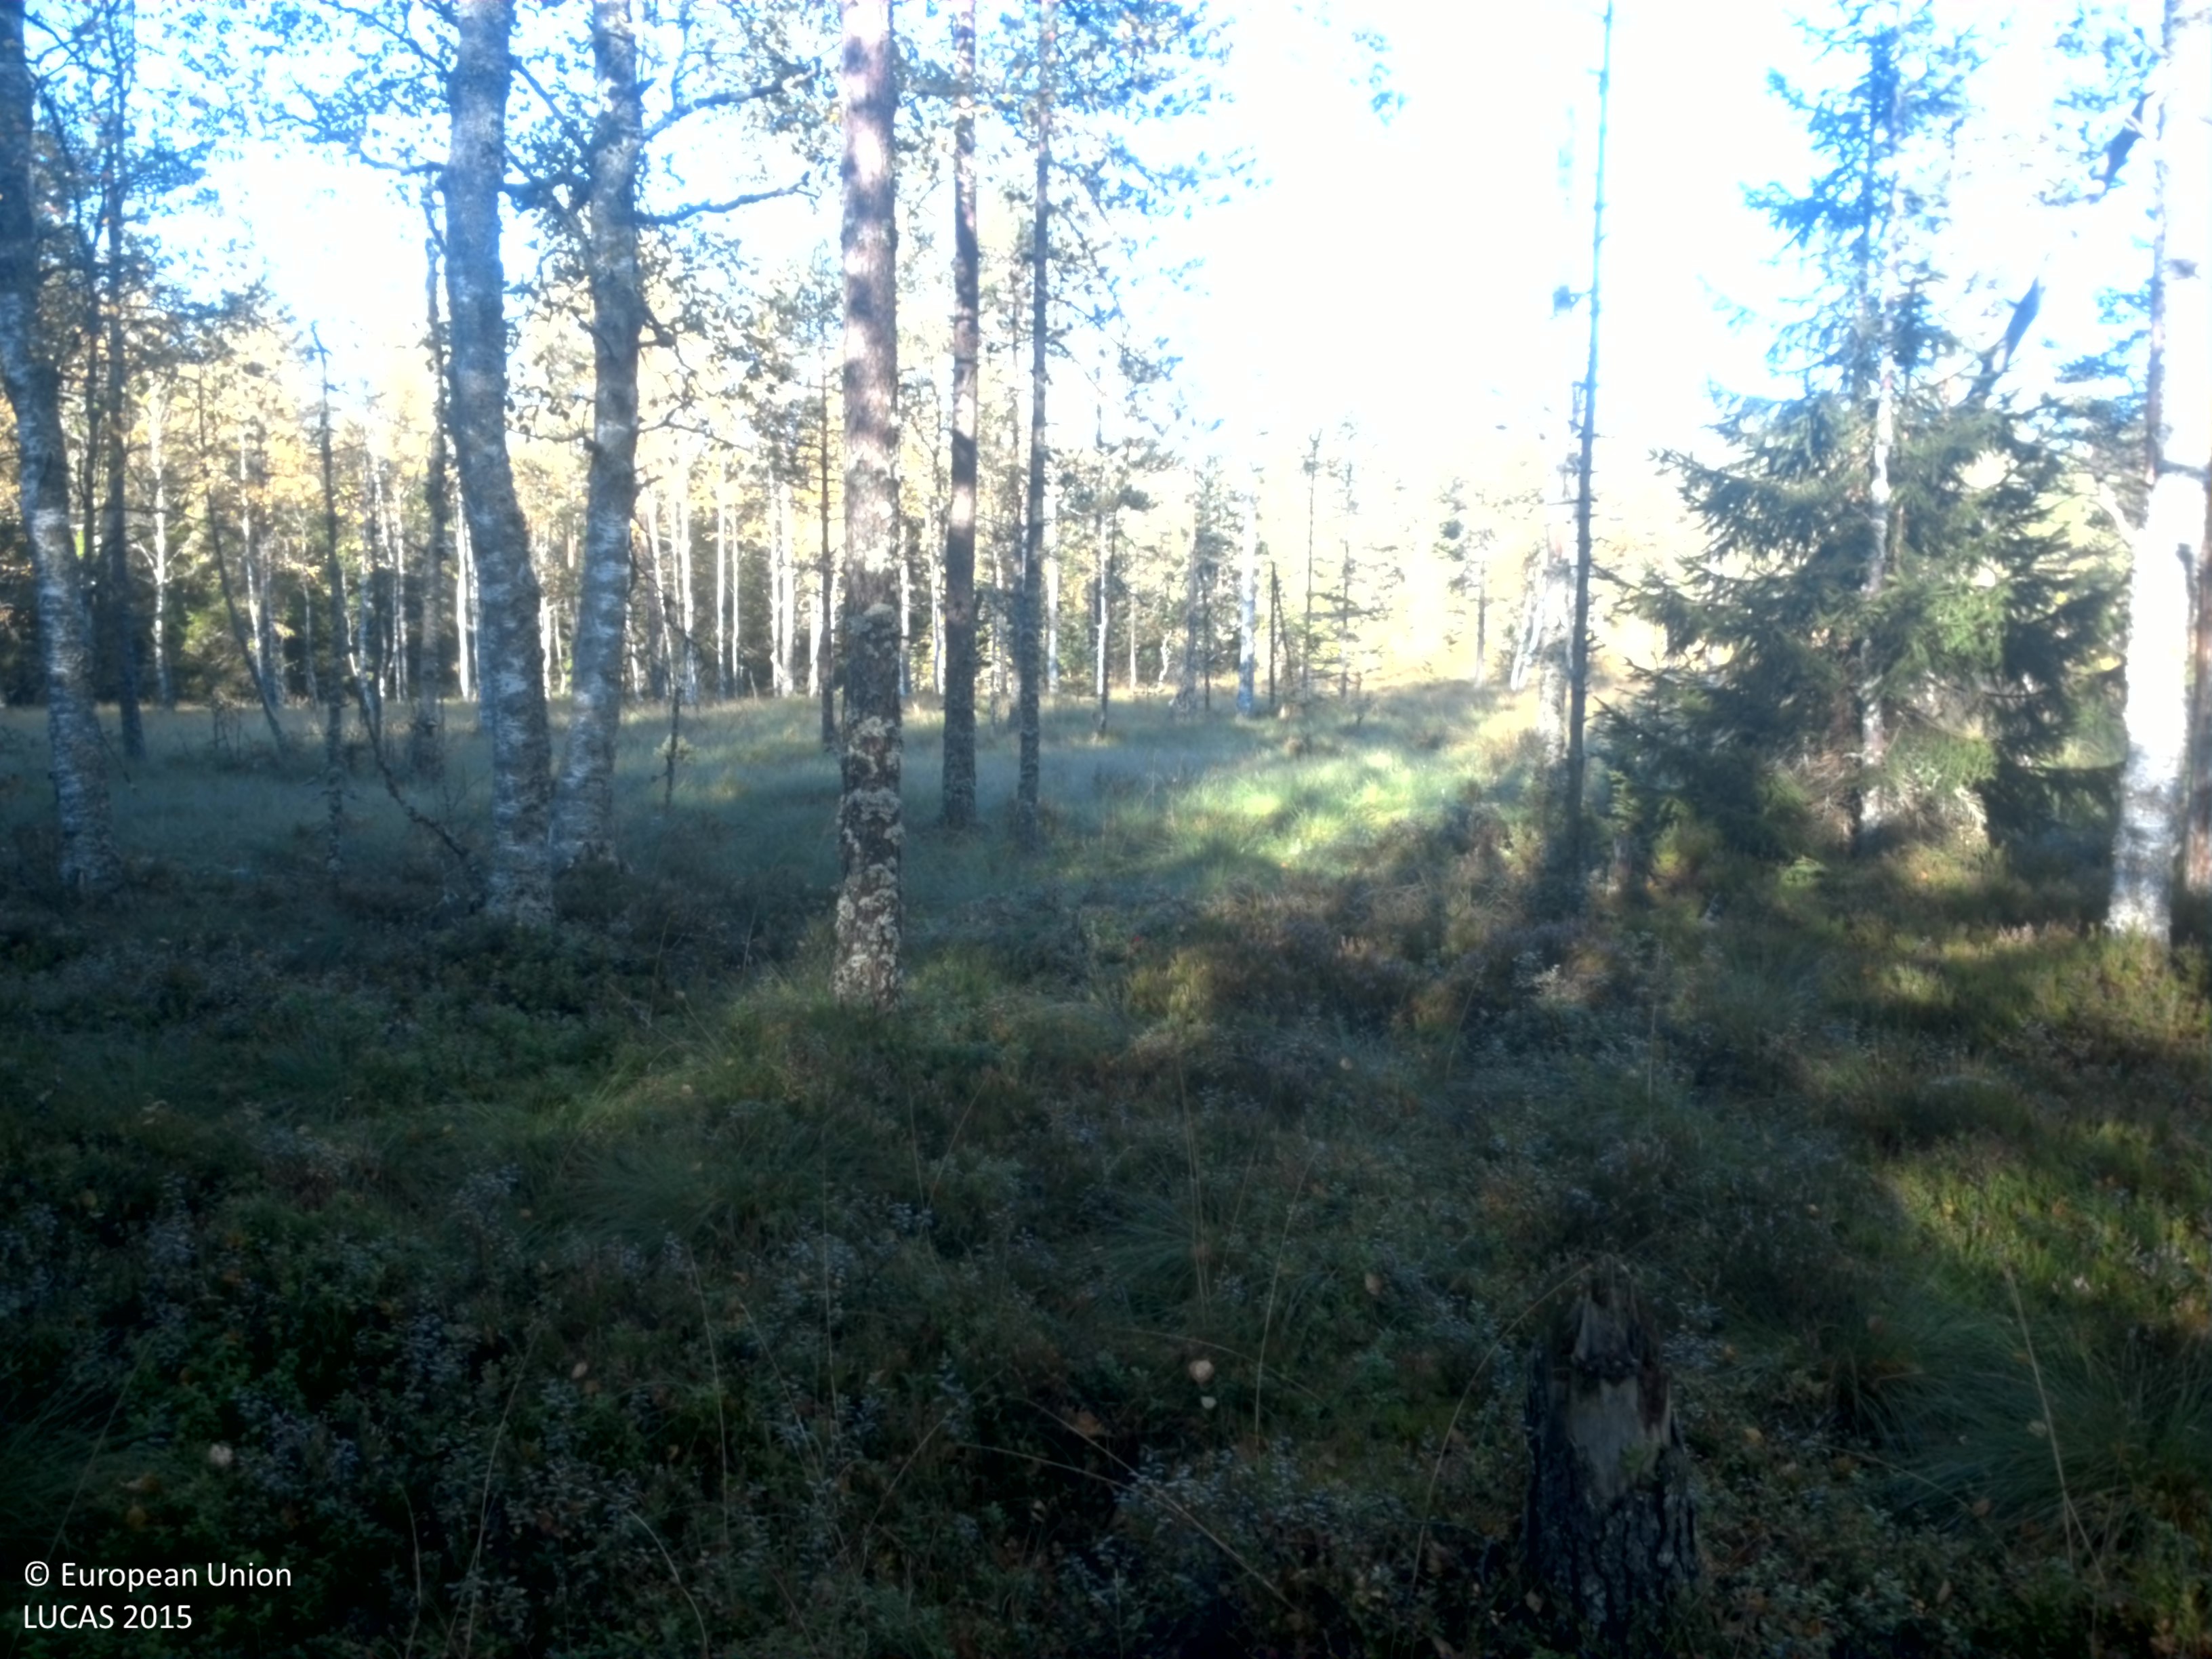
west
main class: Woodland
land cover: Pine dominated mixed woodland
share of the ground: 25 - 50 %
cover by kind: herbaceous plants 50 %, coniferous forest trees 15 %, broadleaved forest trees 15 %, shrubs 10 %, lichens and mosses 10 %
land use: Forestry
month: September
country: SE
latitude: 59.9213
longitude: 15.2307
